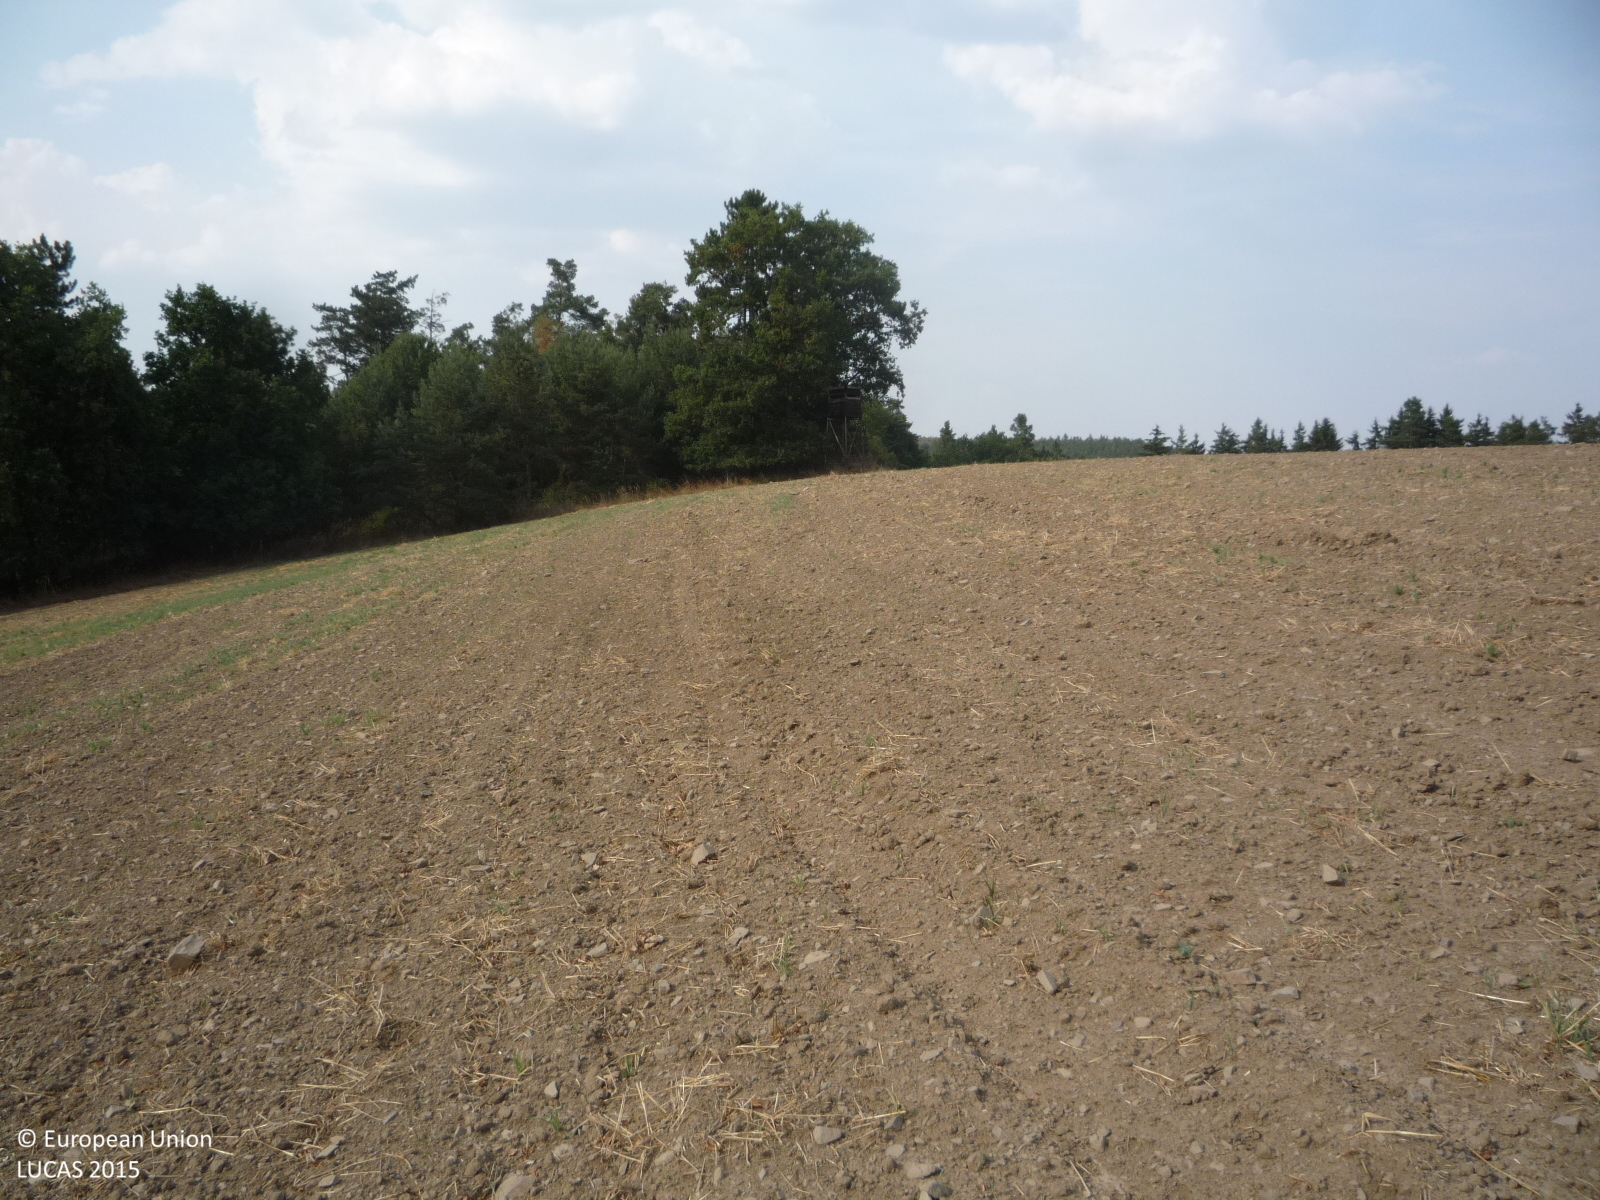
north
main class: Cropland
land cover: Barley
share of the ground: < 10 %
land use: Agriculture (excluding fallow land and kitchen gardens)
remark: Harvested field
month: August
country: CZ
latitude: 49.7897
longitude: 14.4882
